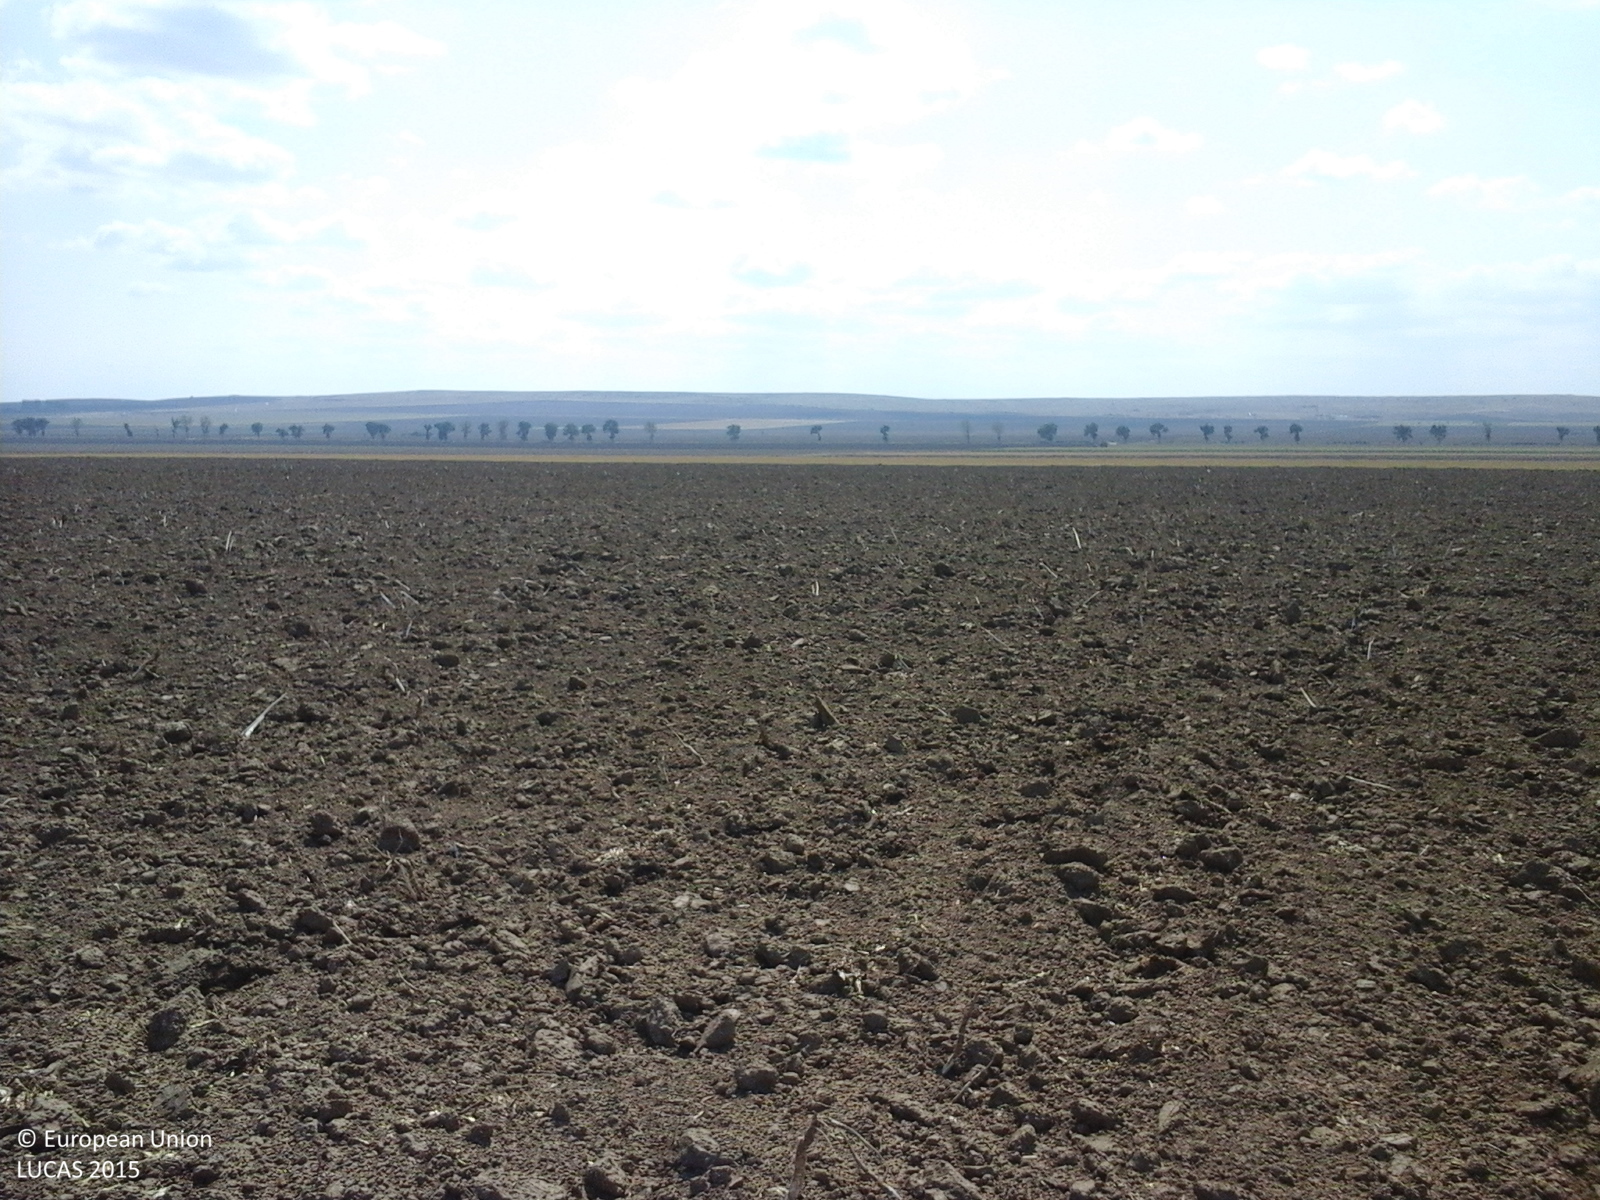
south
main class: Cropland
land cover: Rape and turnip rape
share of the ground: < 10 %
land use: Agriculture (excluding fallow land and kitchen gardens)
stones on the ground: < 10 %
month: August
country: RO
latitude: 44.8311
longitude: 28.8986
